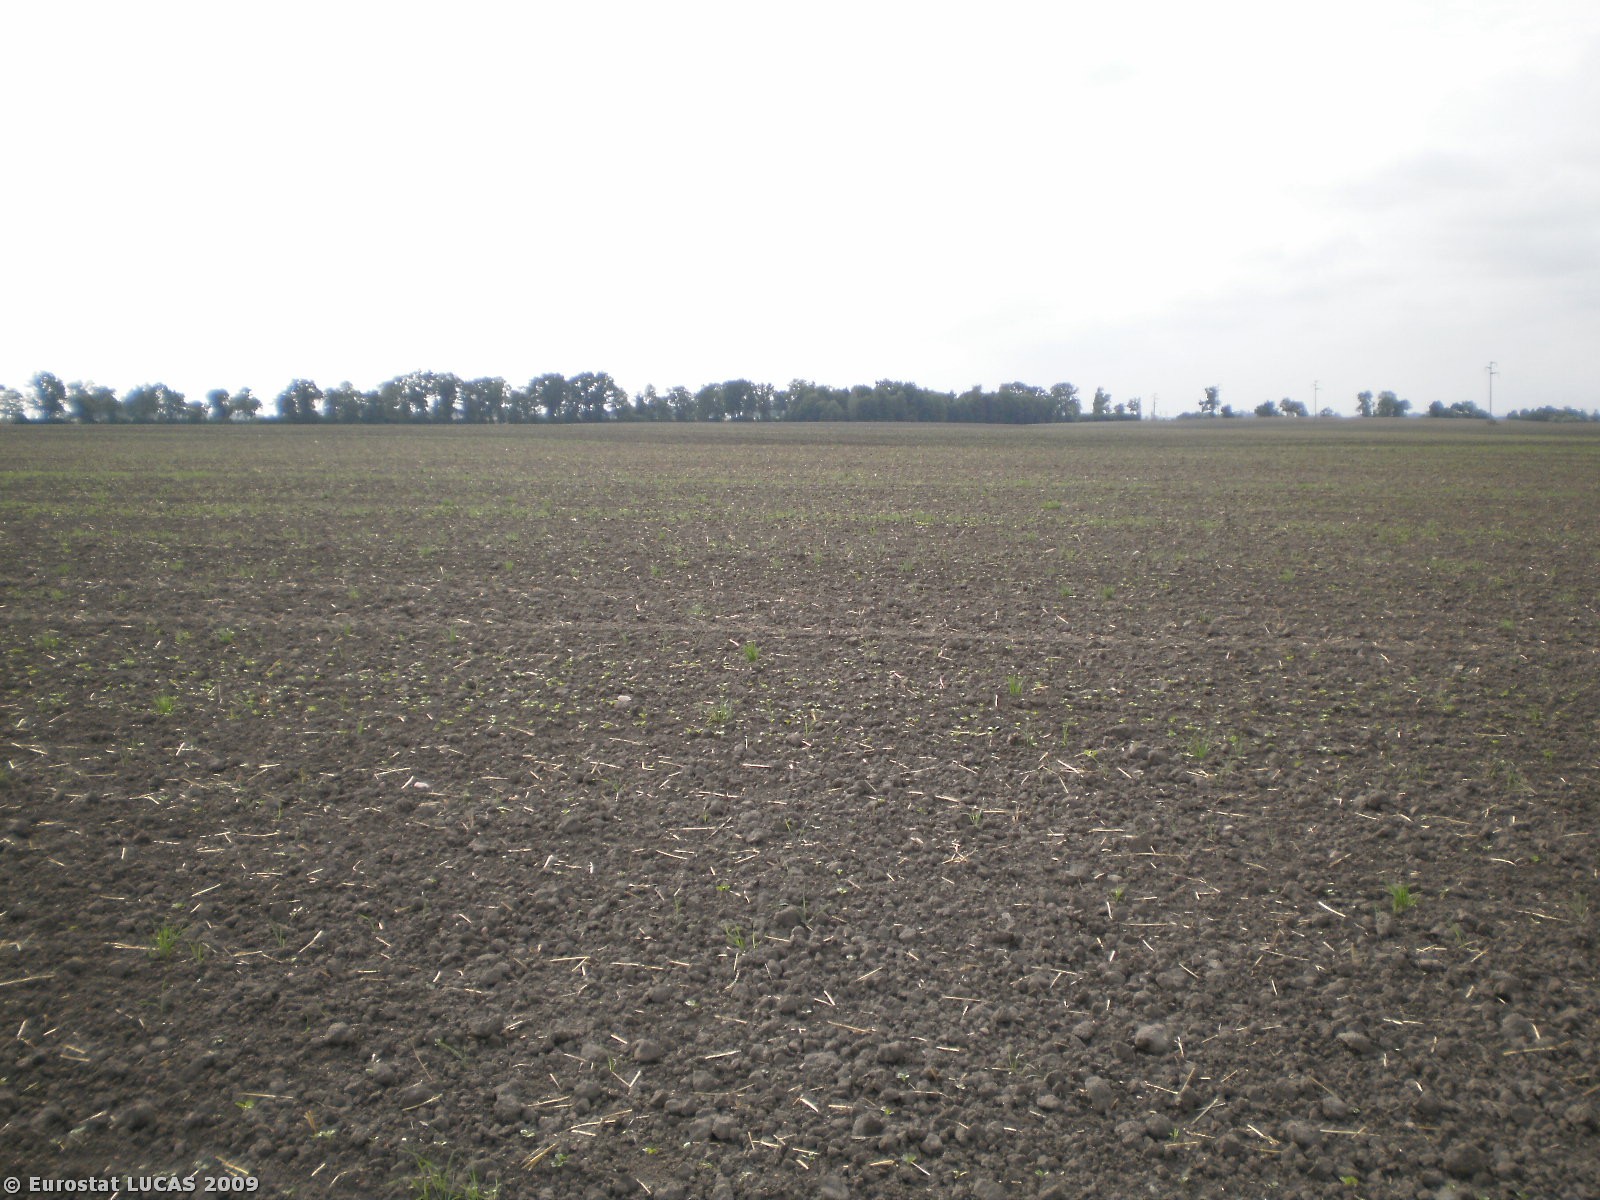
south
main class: Cropland
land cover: Common wheat
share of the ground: < 10 %
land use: Agriculture (excluding fallow land and kitchen gardens)
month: August
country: PL
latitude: 54.2192
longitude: 21.2565
